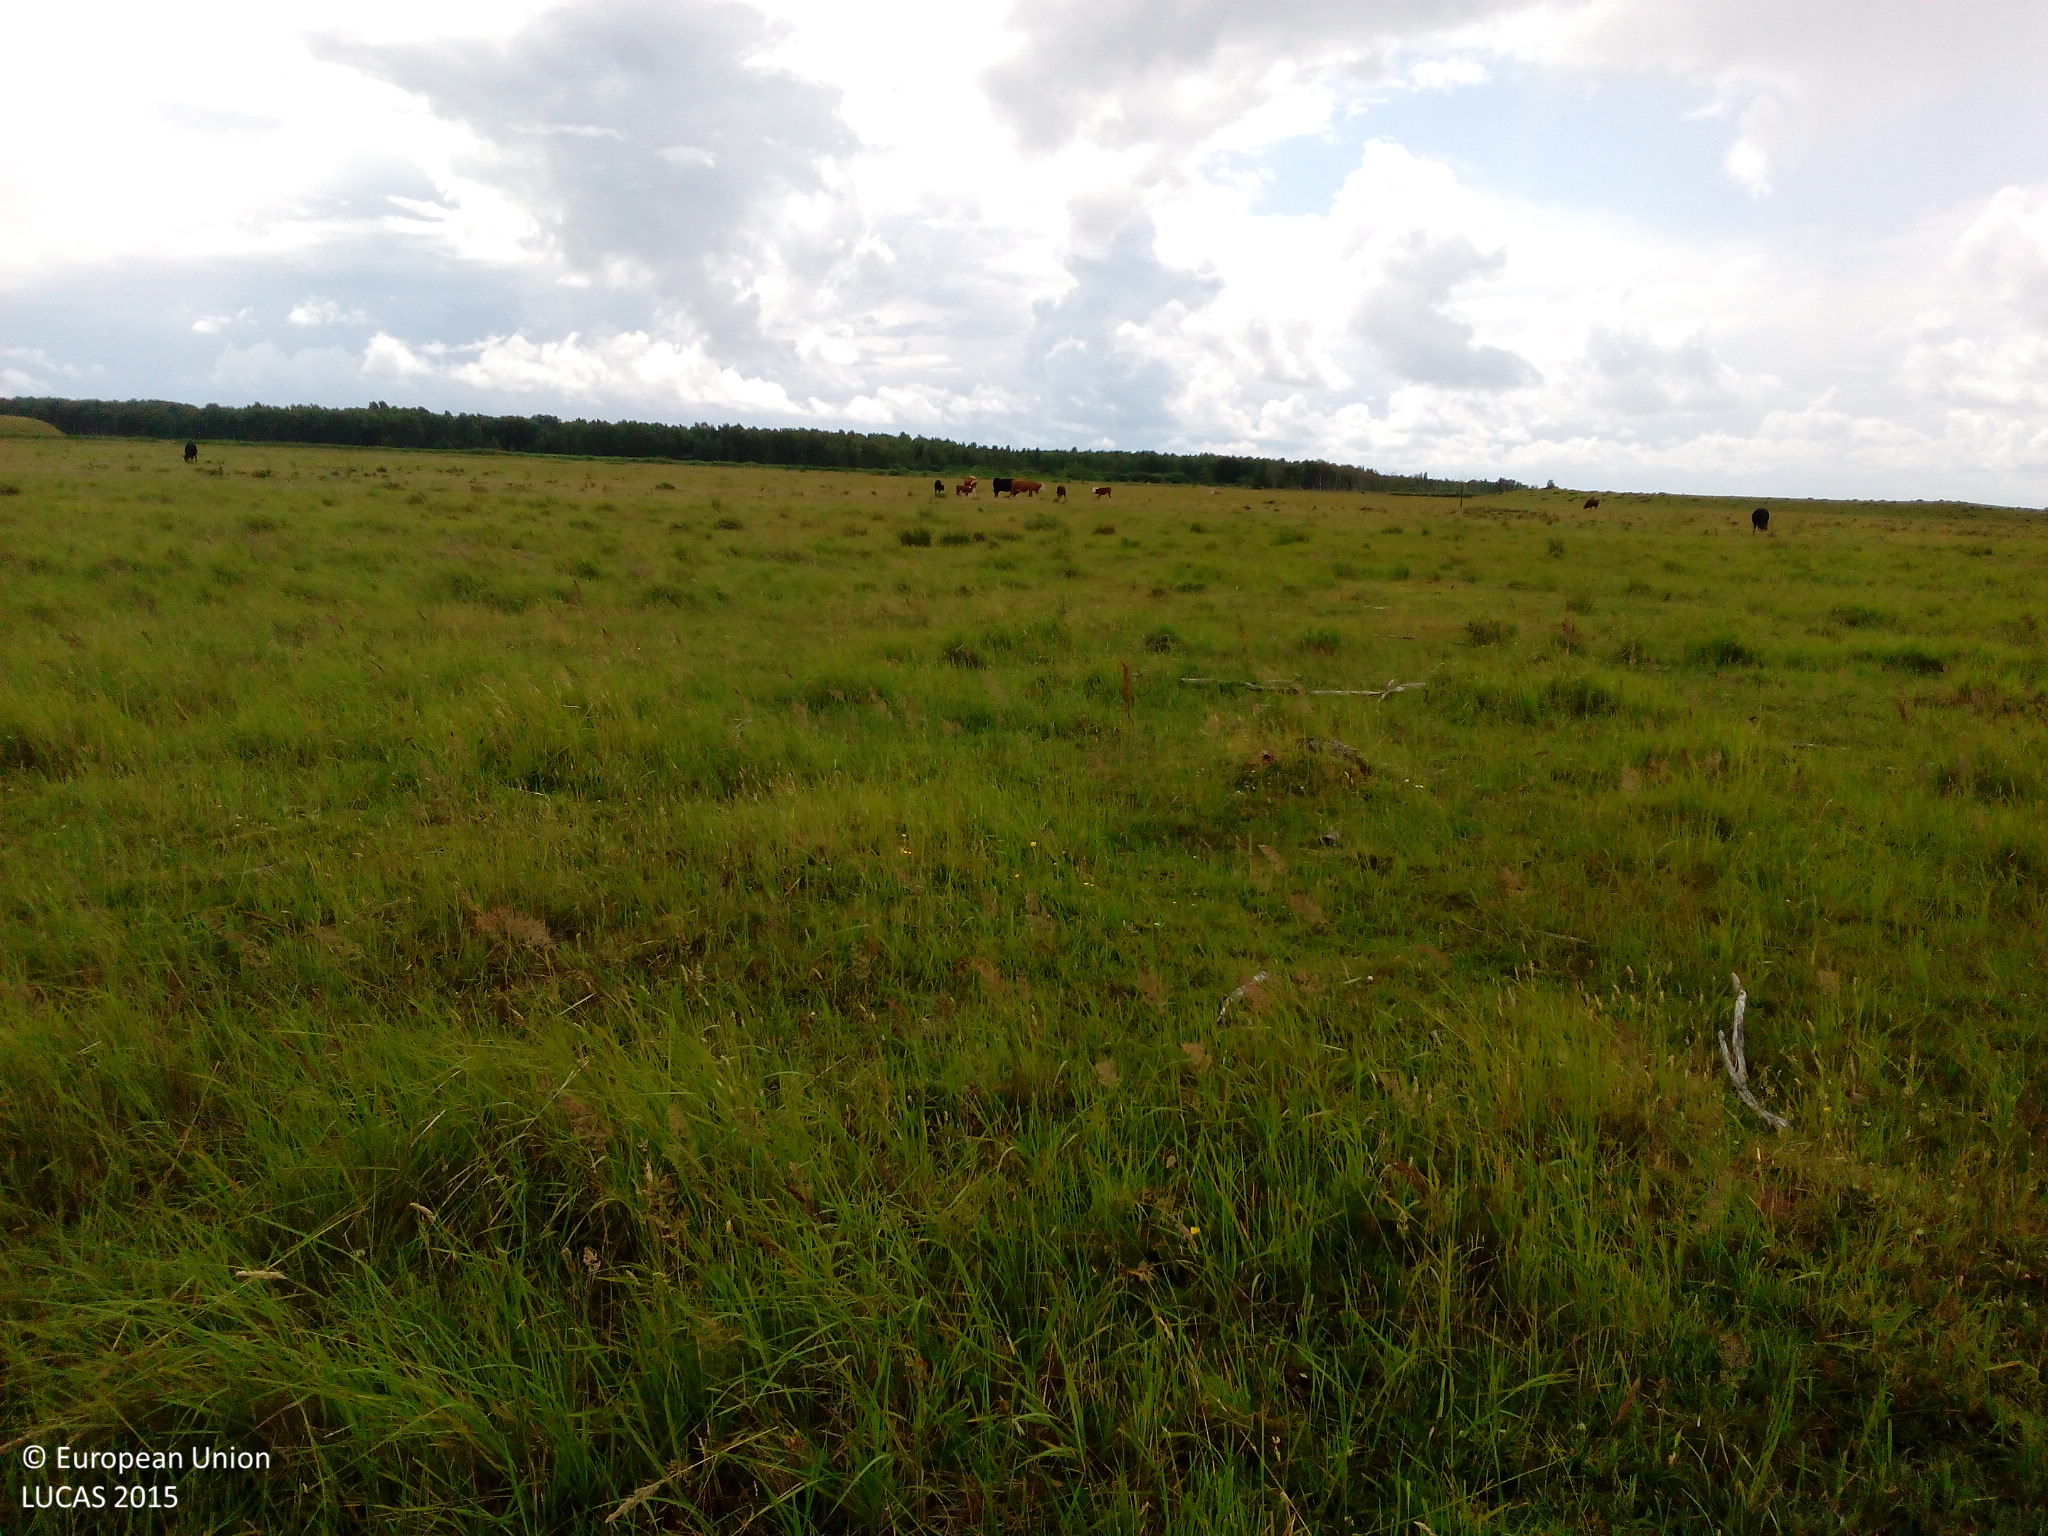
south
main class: Grassland
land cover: Grassland without tree/shrub cover
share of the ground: > 75 %
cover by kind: herbaceous plants 100 %
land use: Agriculture (excluding fallow land and kitchen gardens)
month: July
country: DK
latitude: 55.6048
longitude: 12.5536
